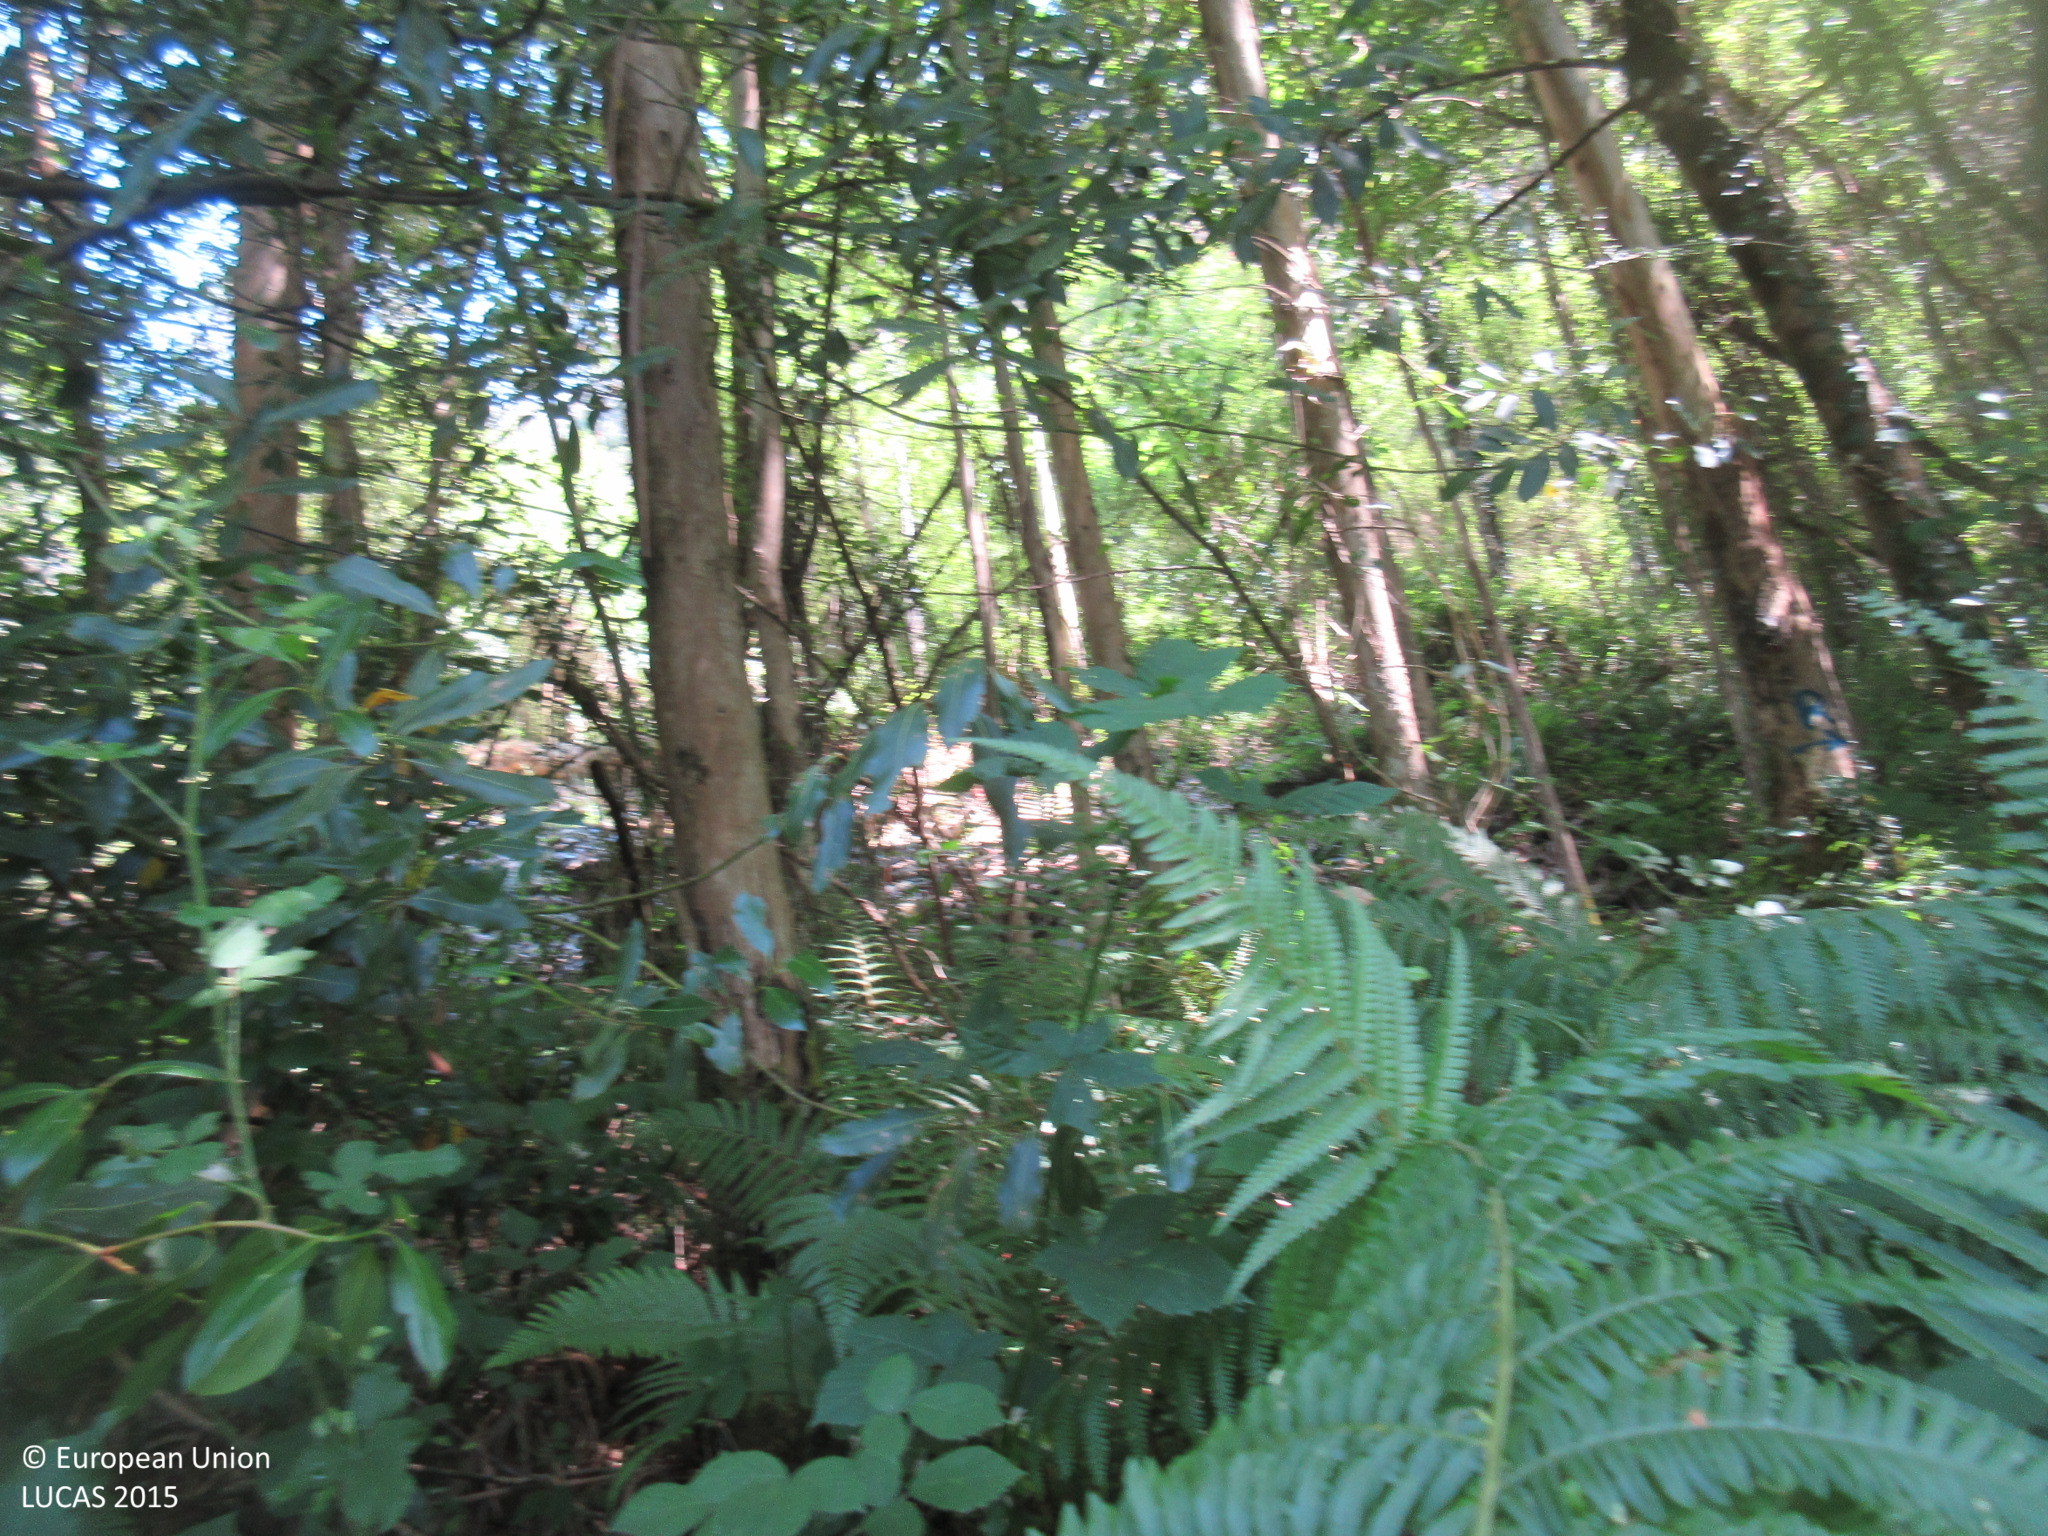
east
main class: Woodland
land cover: Broadleaved woodland
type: exotic forest
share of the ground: > 75 %
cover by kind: broadleaved forest trees 95 %, shrubs 5 %
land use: Forestry
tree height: > 5 m
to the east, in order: Broadleaved woodland; Inland fresh running water; Broadleaved woodland; Electric lines; Broadleaved woodland; Tracks; Broadleaved woodland; Tracks; Broadleaved woodland
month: June
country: ES
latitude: 43.4028
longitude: -7.1730
